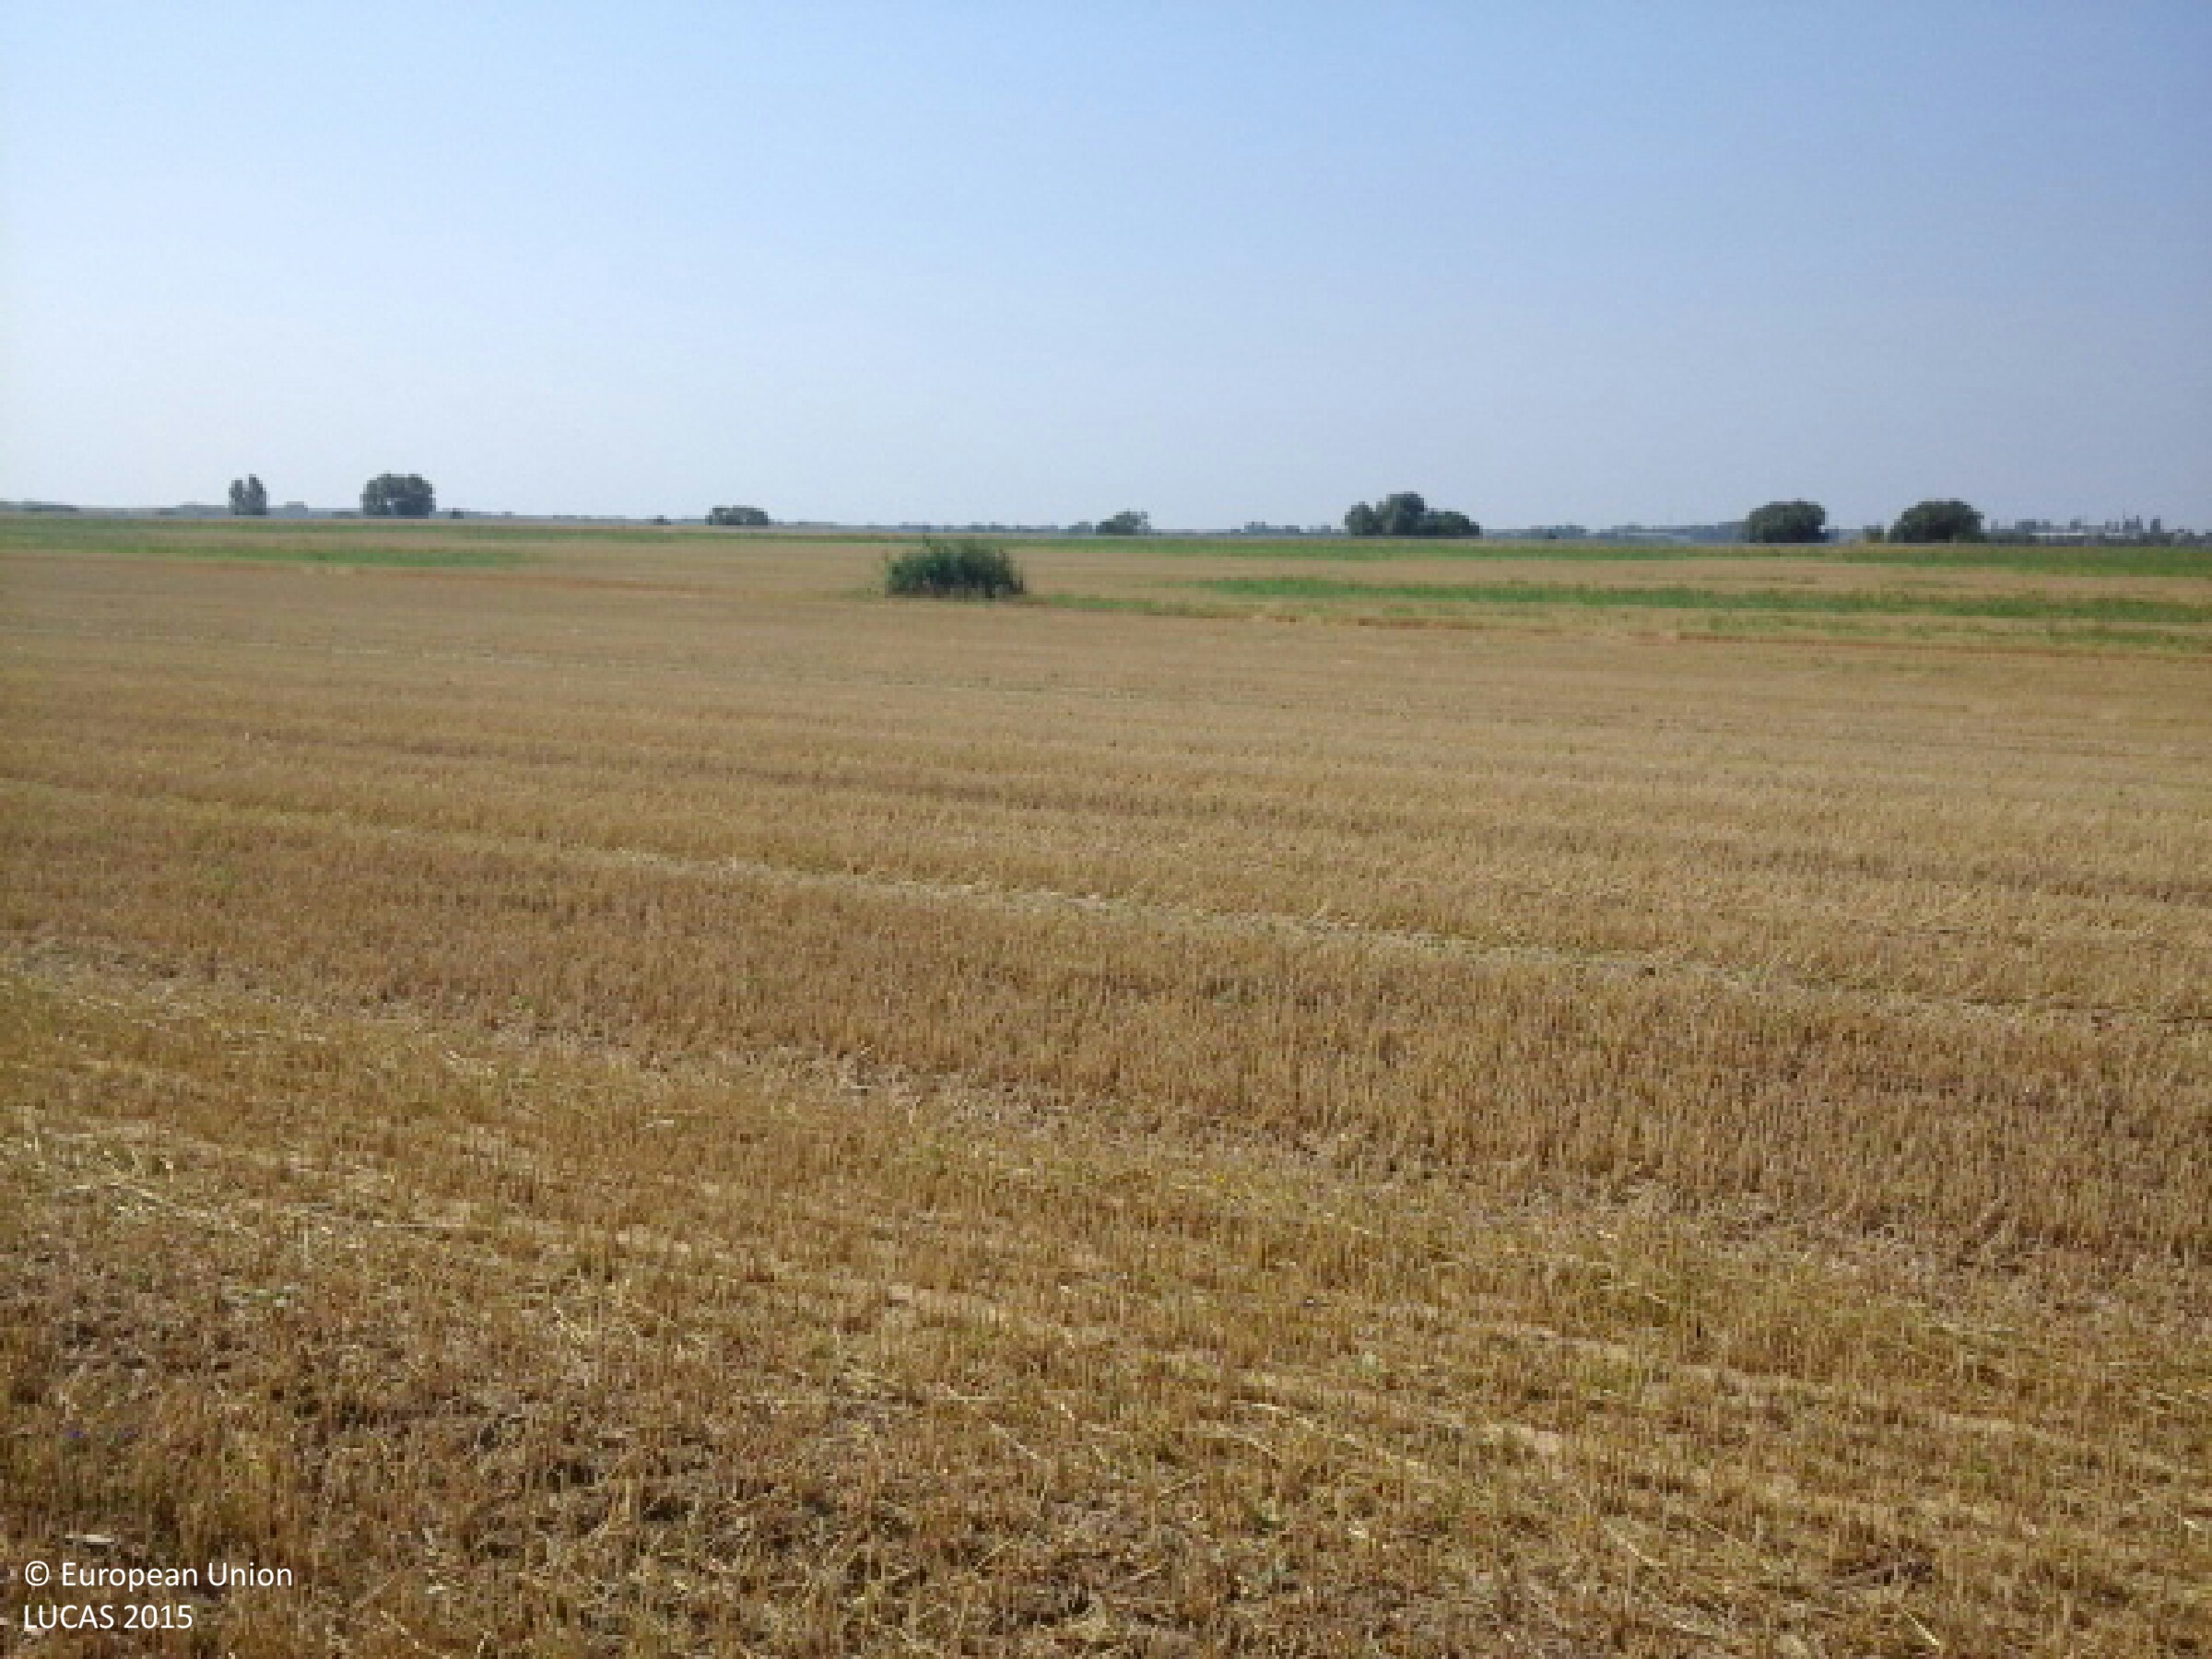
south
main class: Cropland
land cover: Triticale
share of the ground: 10 - 25 %
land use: Agriculture (excluding fallow land and kitchen gardens)
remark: Harvested field
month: August
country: HU
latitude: 47.5451
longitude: 18.1030
